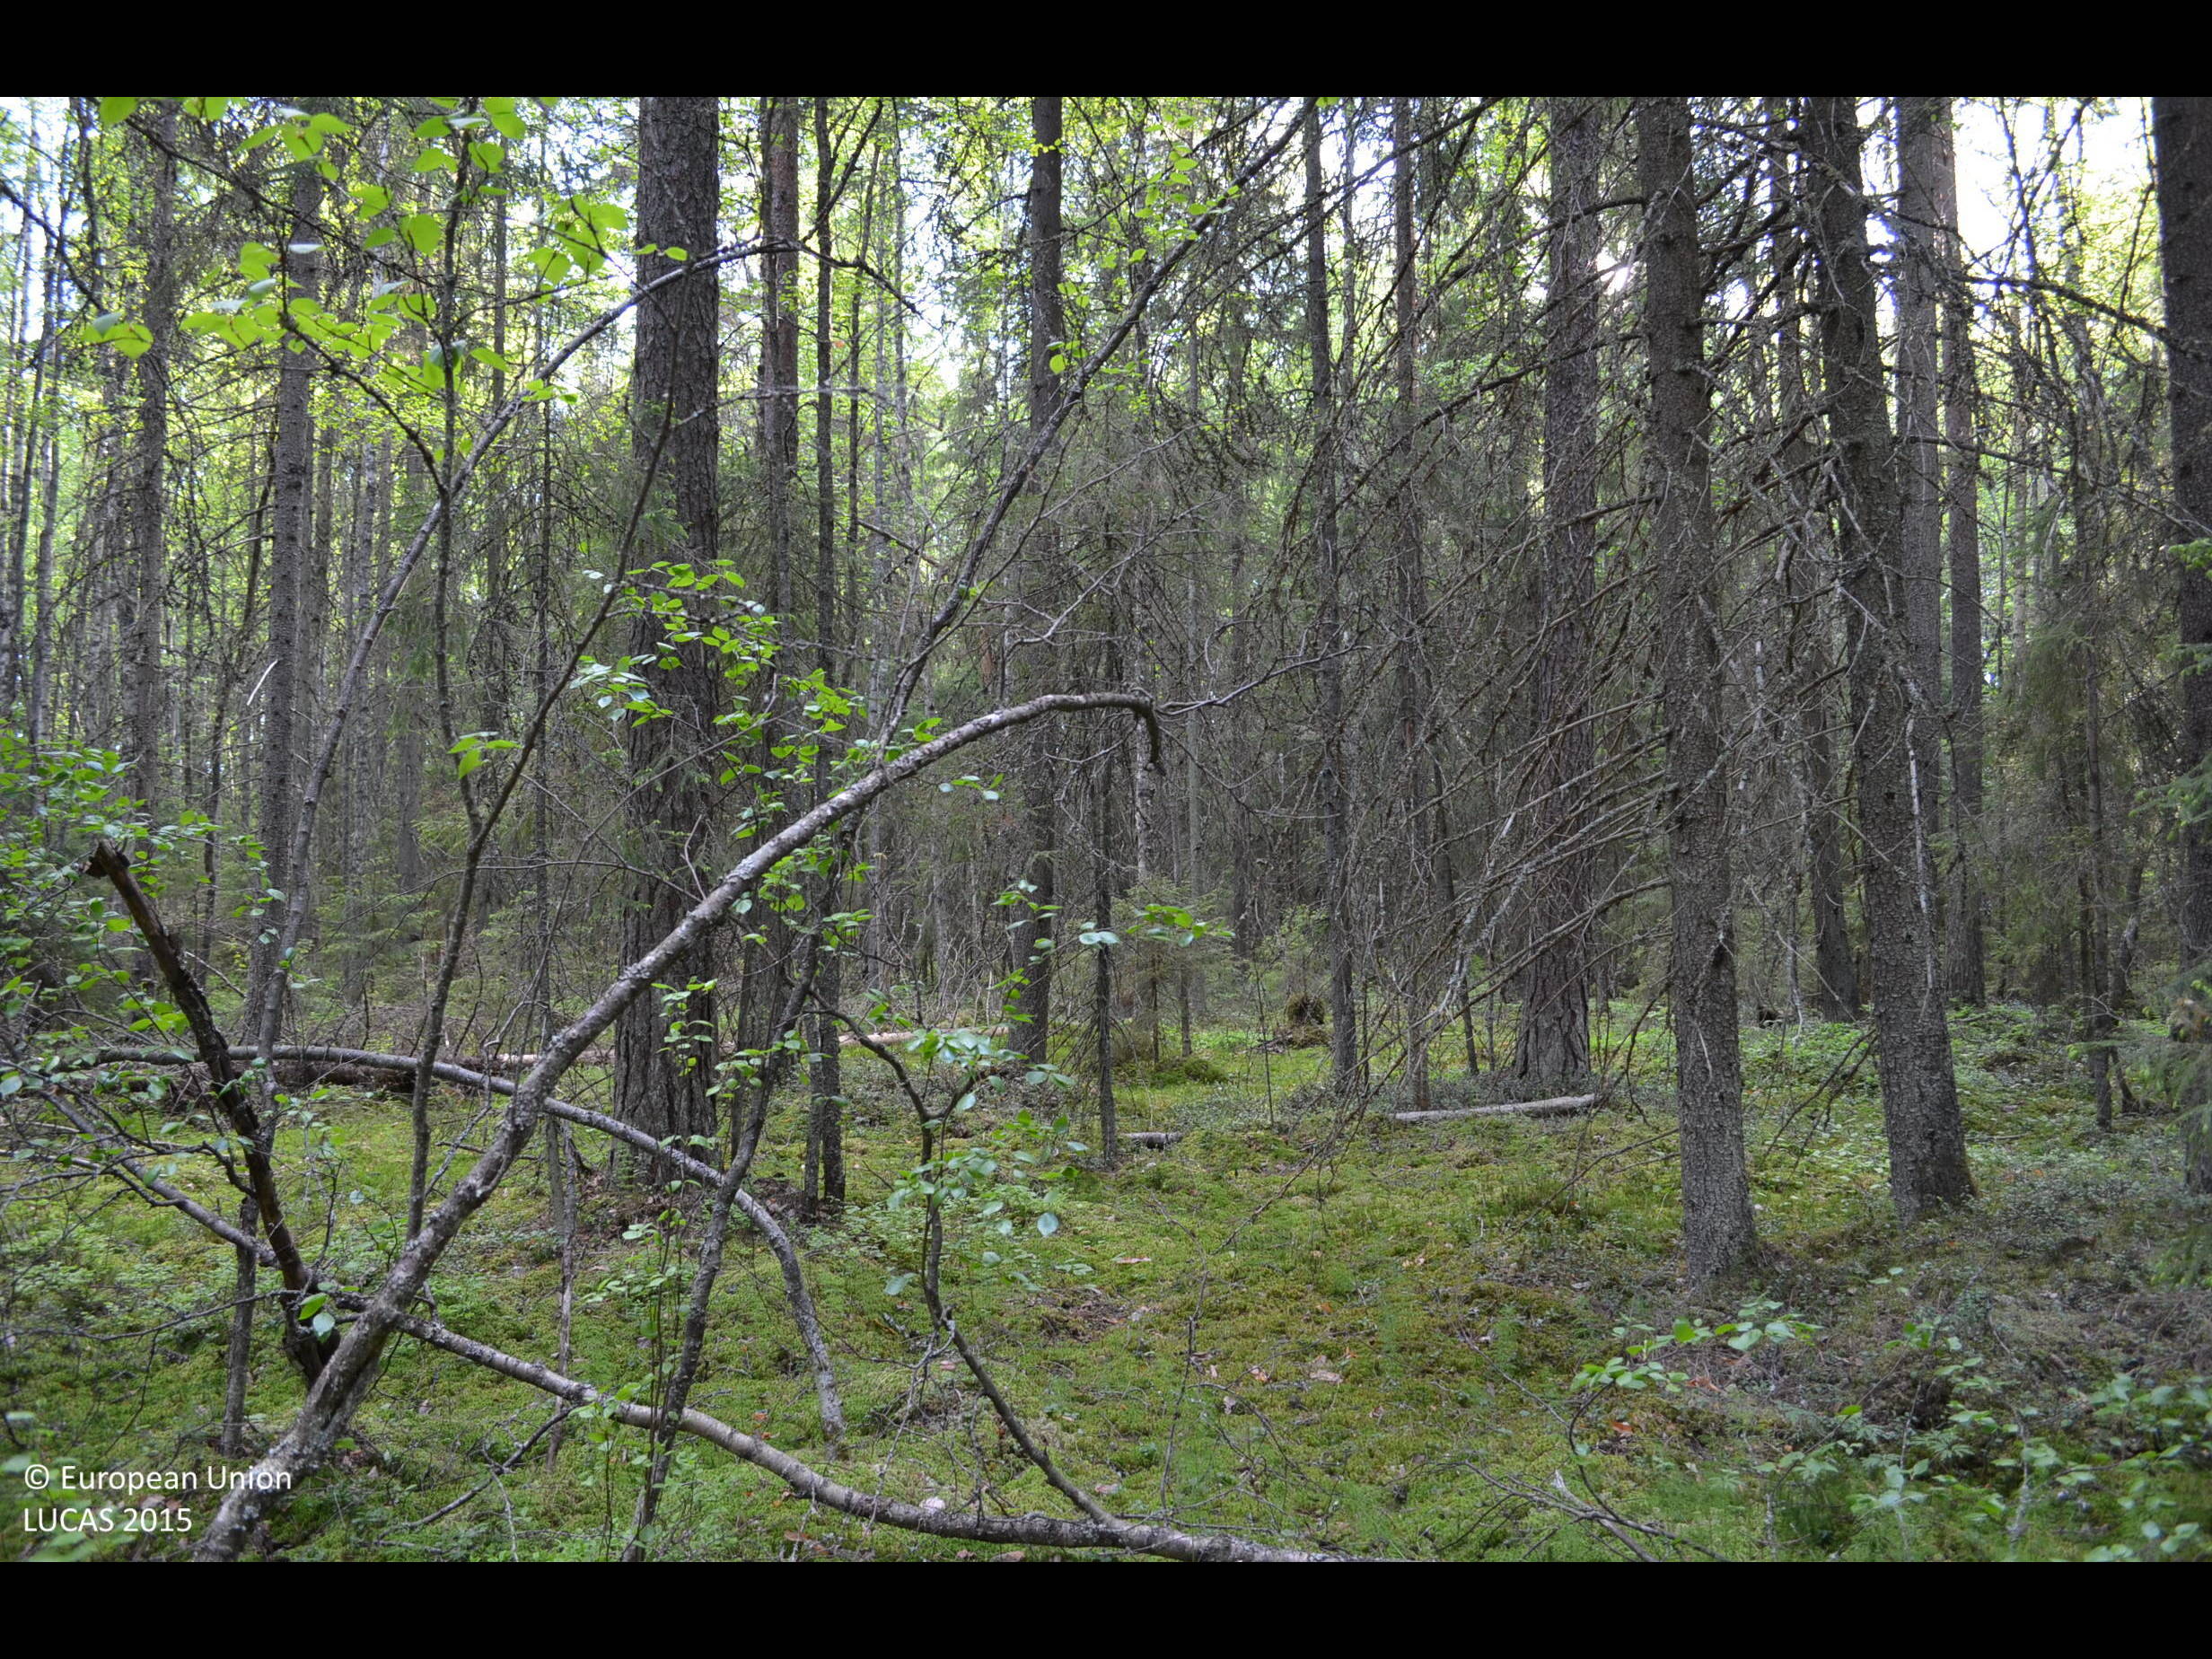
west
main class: Woodland
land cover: Spruce dominated coniferous woodland
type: boreal forest
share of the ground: > 75 %
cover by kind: coniferous forest trees 70 %, lichens and mosses 15 %, broadleaved forest trees 5 %, shrubs 5 %, herbaceous plants 5 %
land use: Forestry
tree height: > 5 m
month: June
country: FI
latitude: 61.6474
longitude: 23.1535
